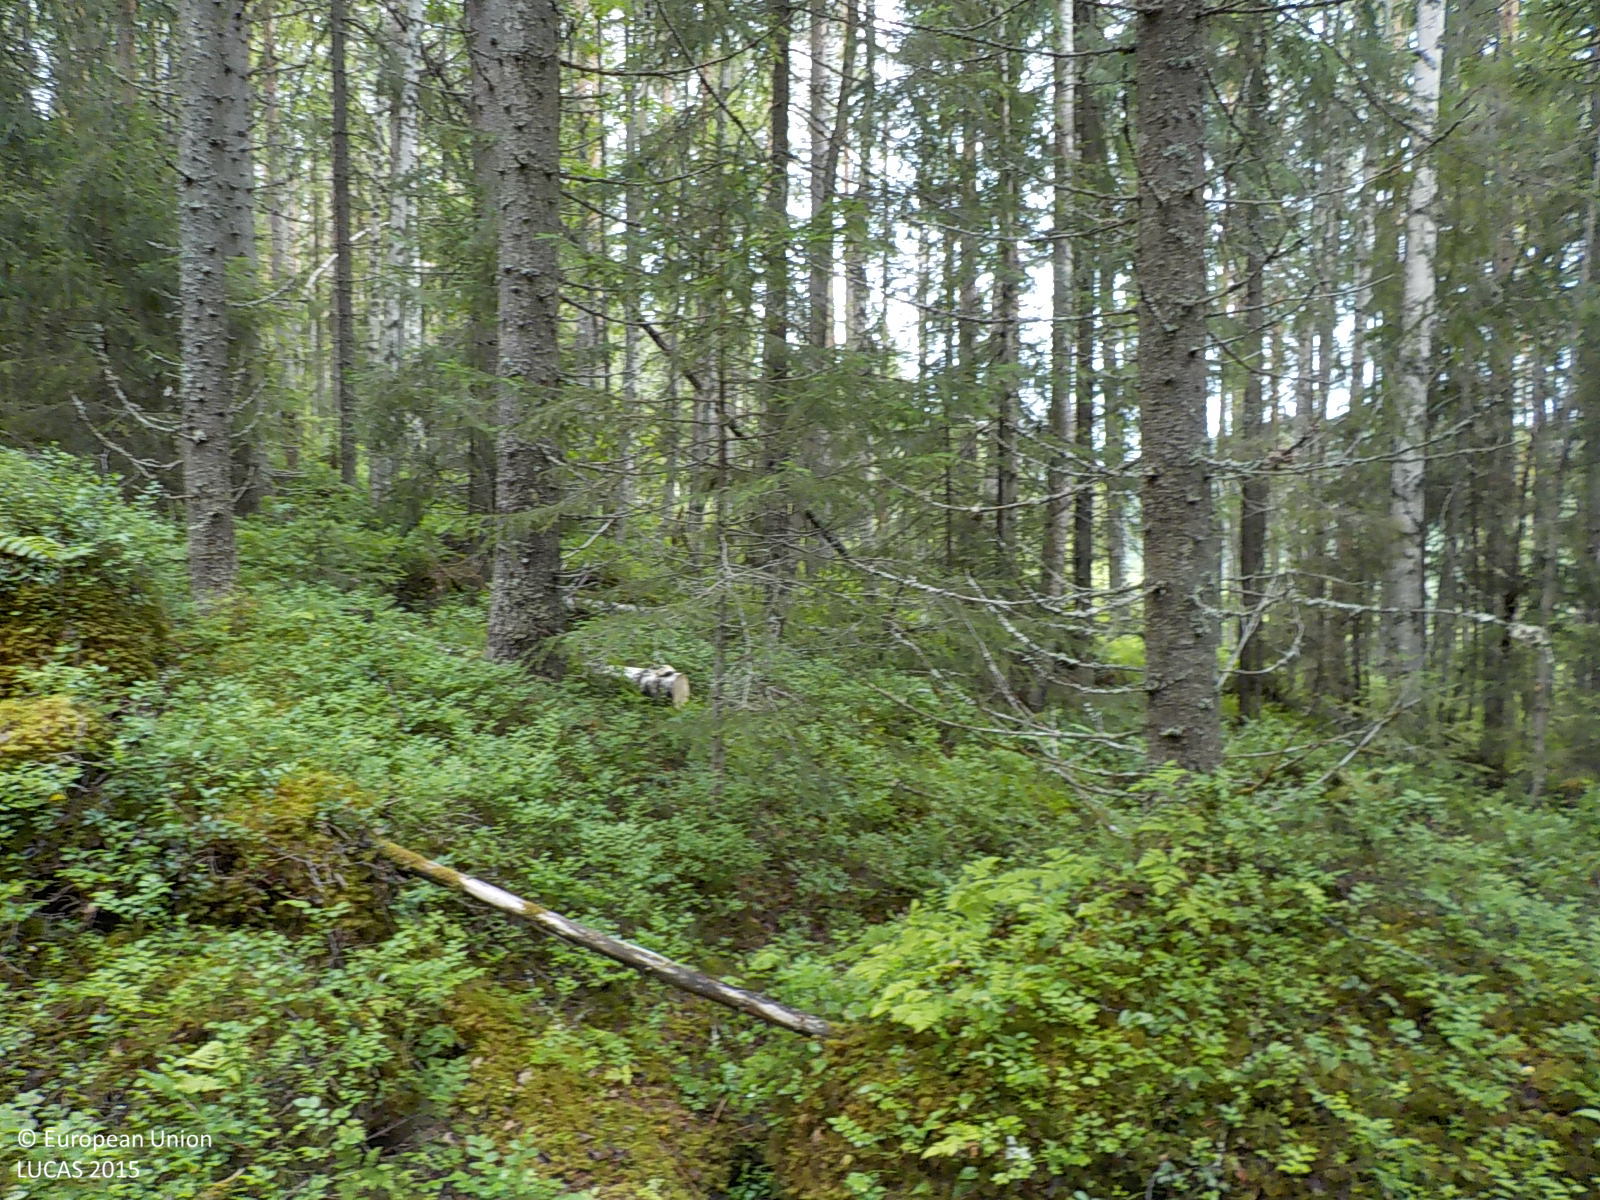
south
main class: Woodland
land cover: Spruce dominated coniferous woodland
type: boreal forest
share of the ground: 50 - 75 %
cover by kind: coniferous forest trees 60 %, shrubs 25 %, lichens and mosses 15 %
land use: Forestry
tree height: > 5 m
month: July
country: SE
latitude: 63.3090
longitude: 17.2185
